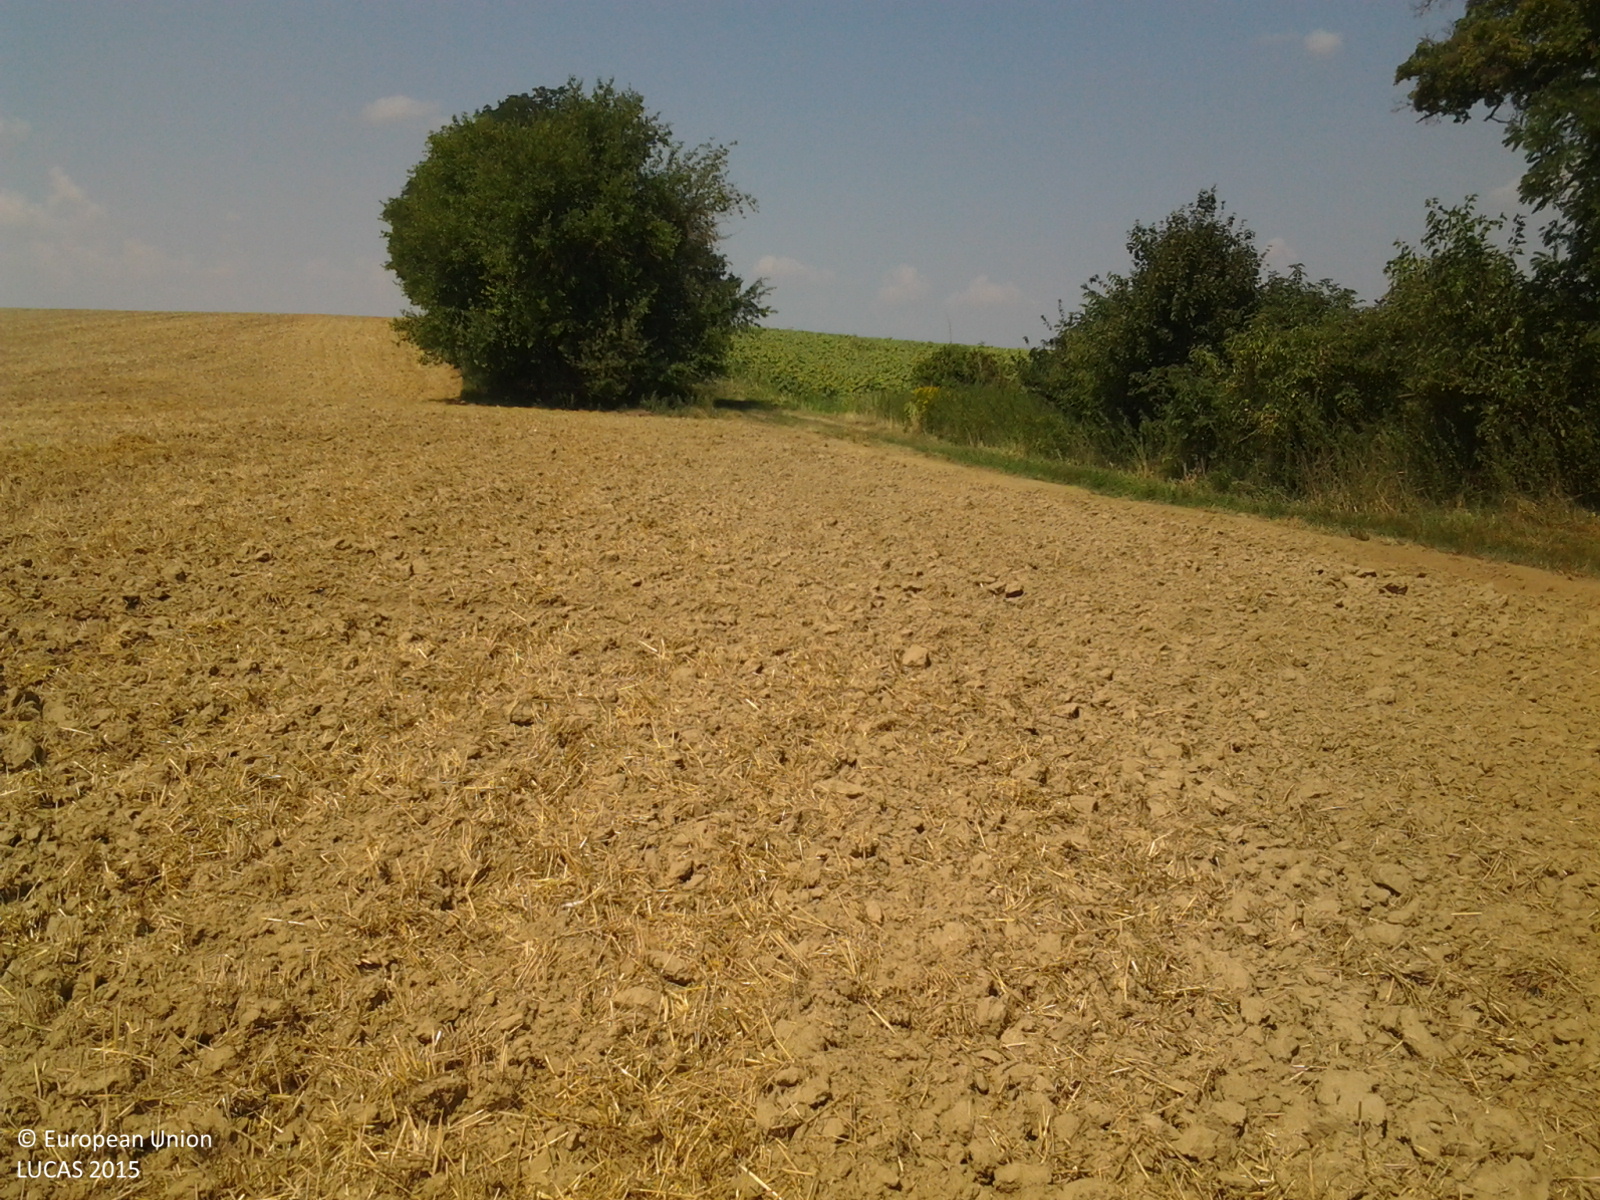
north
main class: Cropland
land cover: Triticale
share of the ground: < 10 %
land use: Agriculture (excluding fallow land and kitchen gardens)
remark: Harvested field
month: August
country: HU
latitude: 46.4505
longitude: 18.2231
